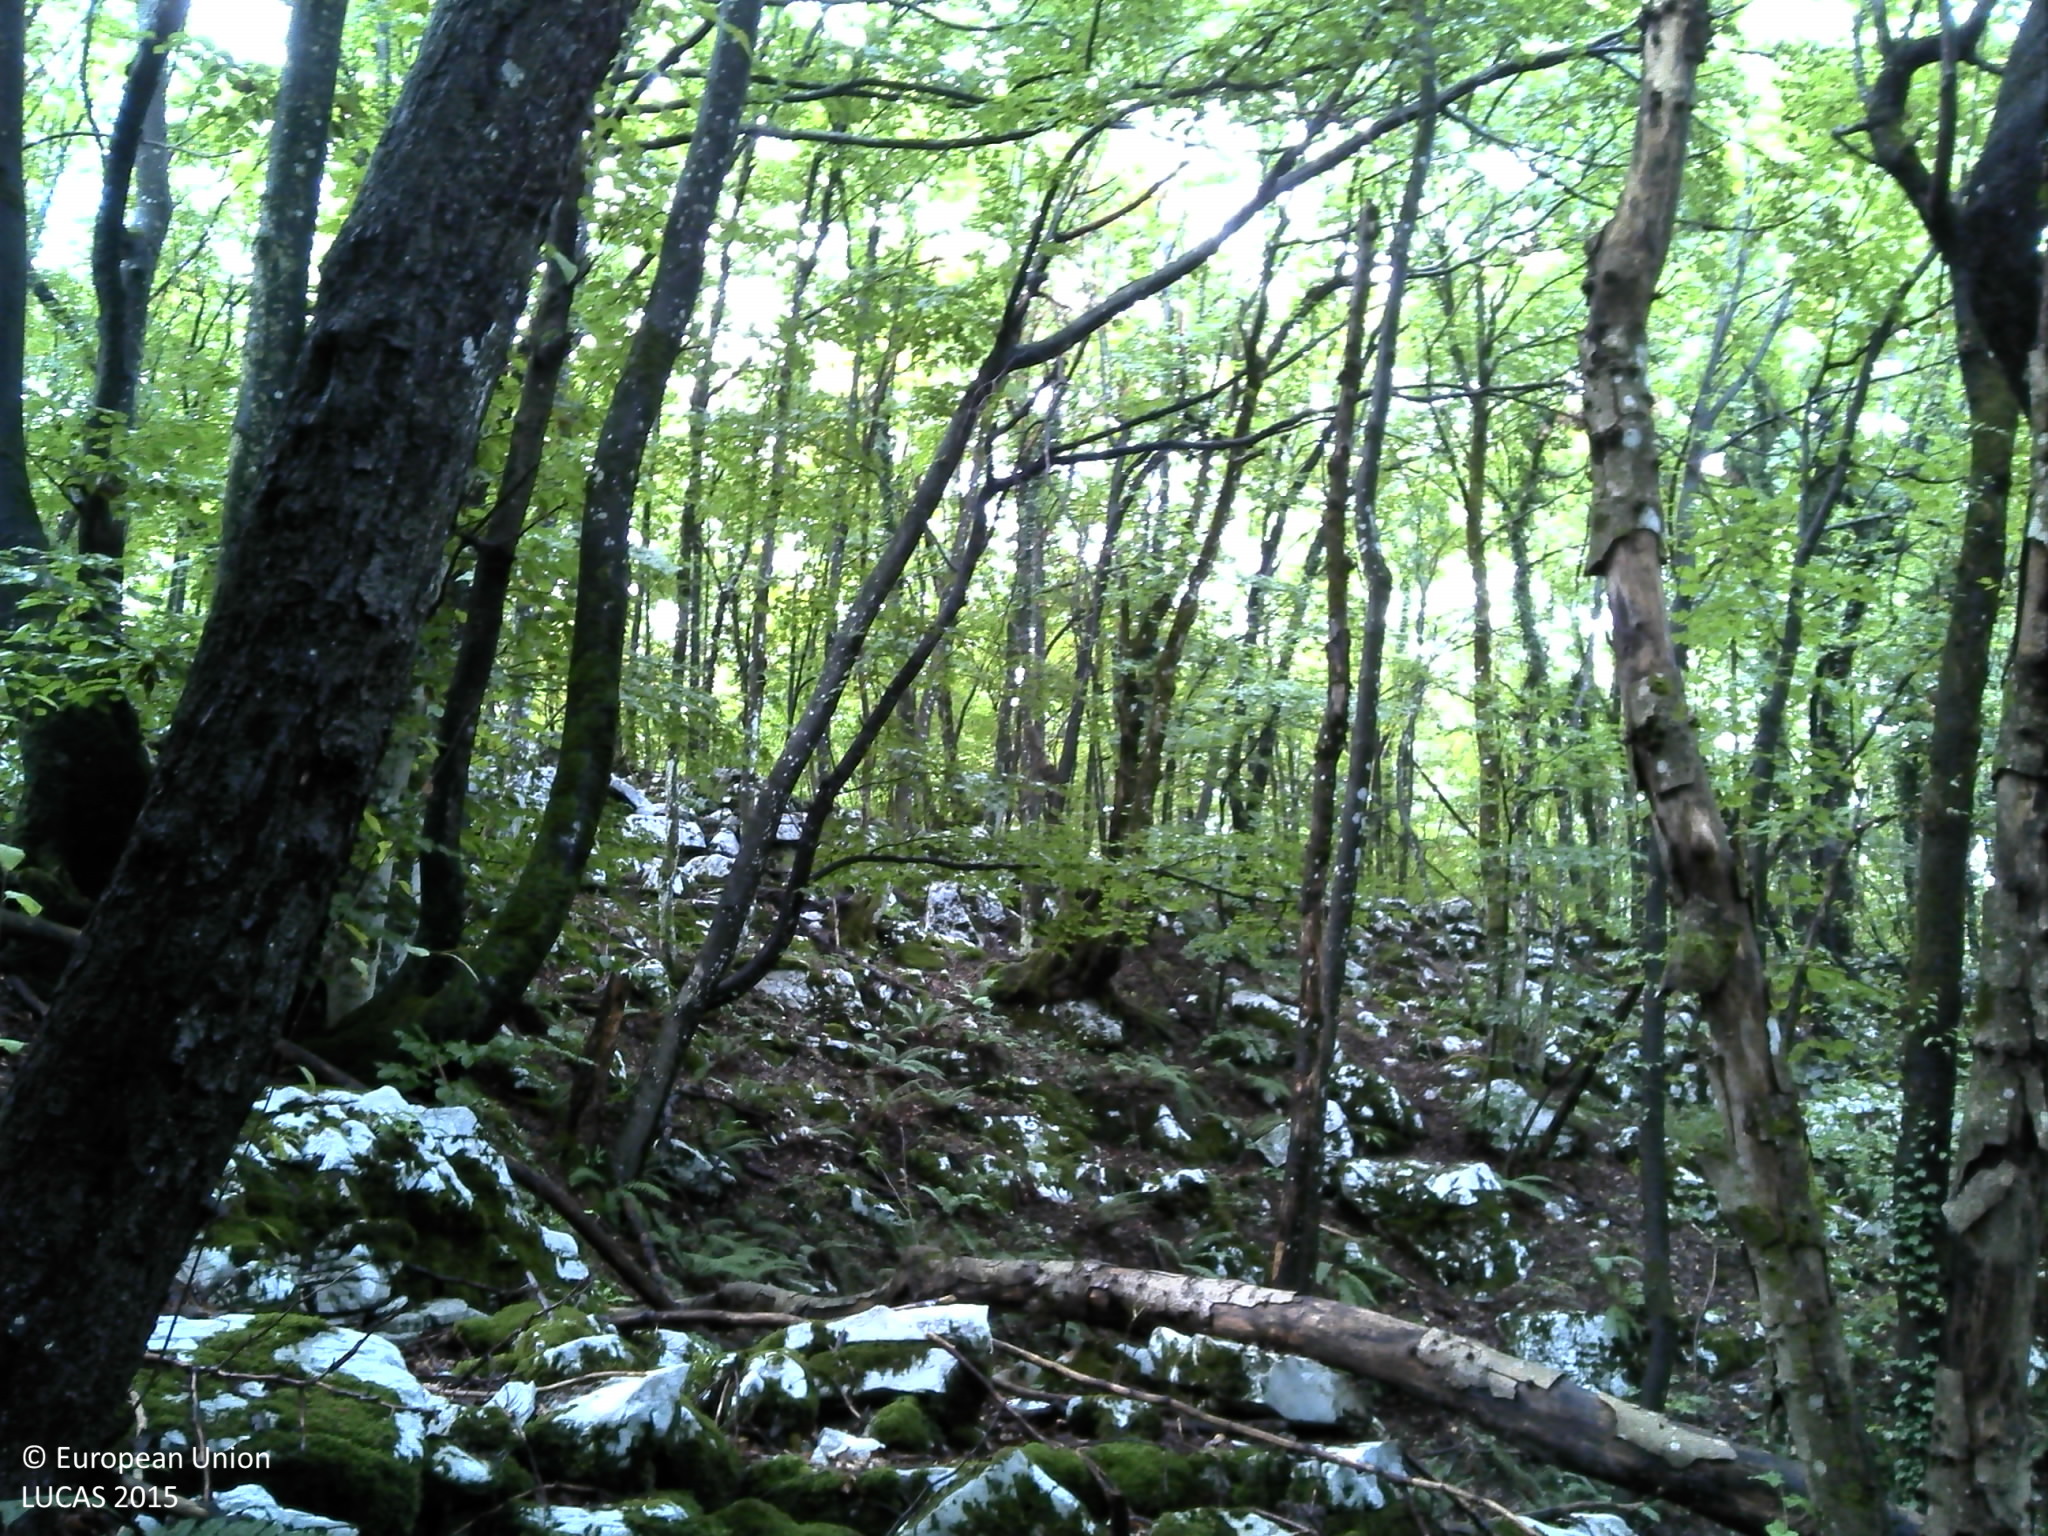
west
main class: Woodland
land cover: Broadleaved woodland
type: beech forest
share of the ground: > 75 %
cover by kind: broadleaved forest trees 100 %
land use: Forestry
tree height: > 5 m
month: September
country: HR
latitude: 45.2650
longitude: 15.2589
